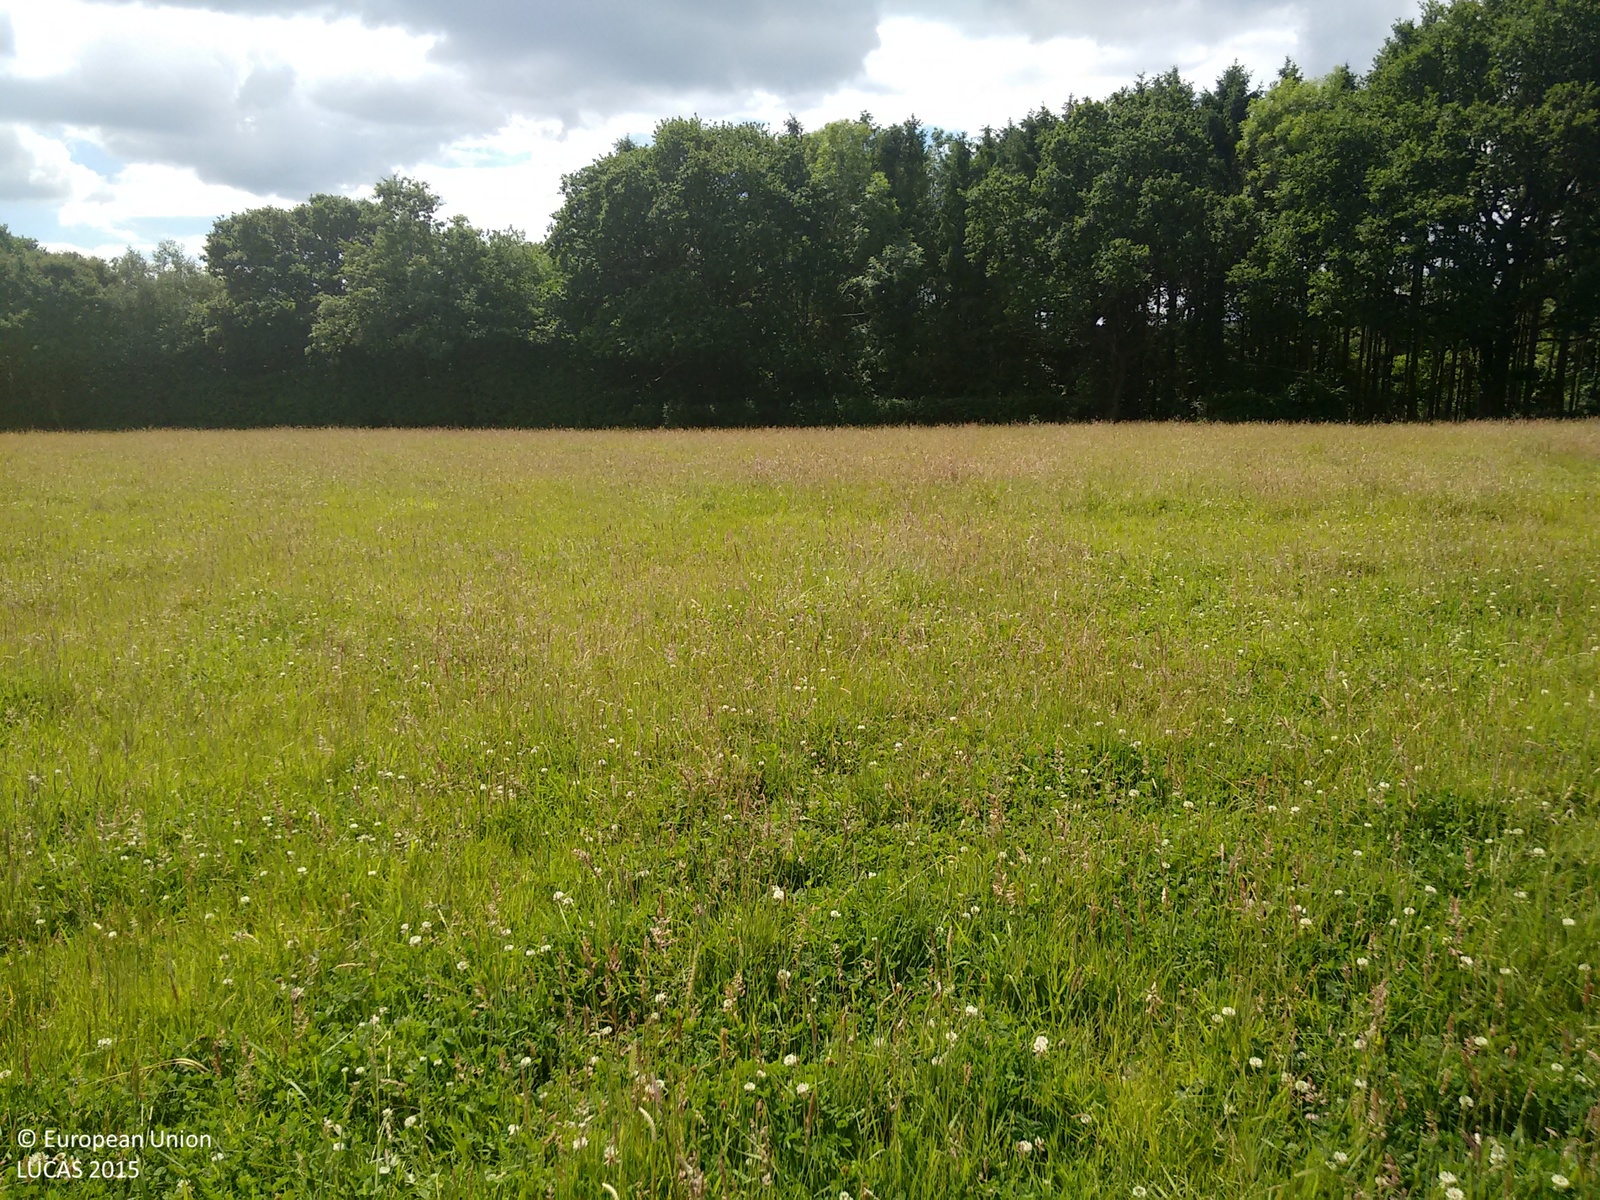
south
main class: Grassland
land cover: Grassland without tree/shrub cover
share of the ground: > 75 %
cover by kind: herbaceous plants 100 %
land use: Agriculture (excluding fallow land and kitchen gardens)
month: June
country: GB
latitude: 50.7797
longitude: -2.0430
